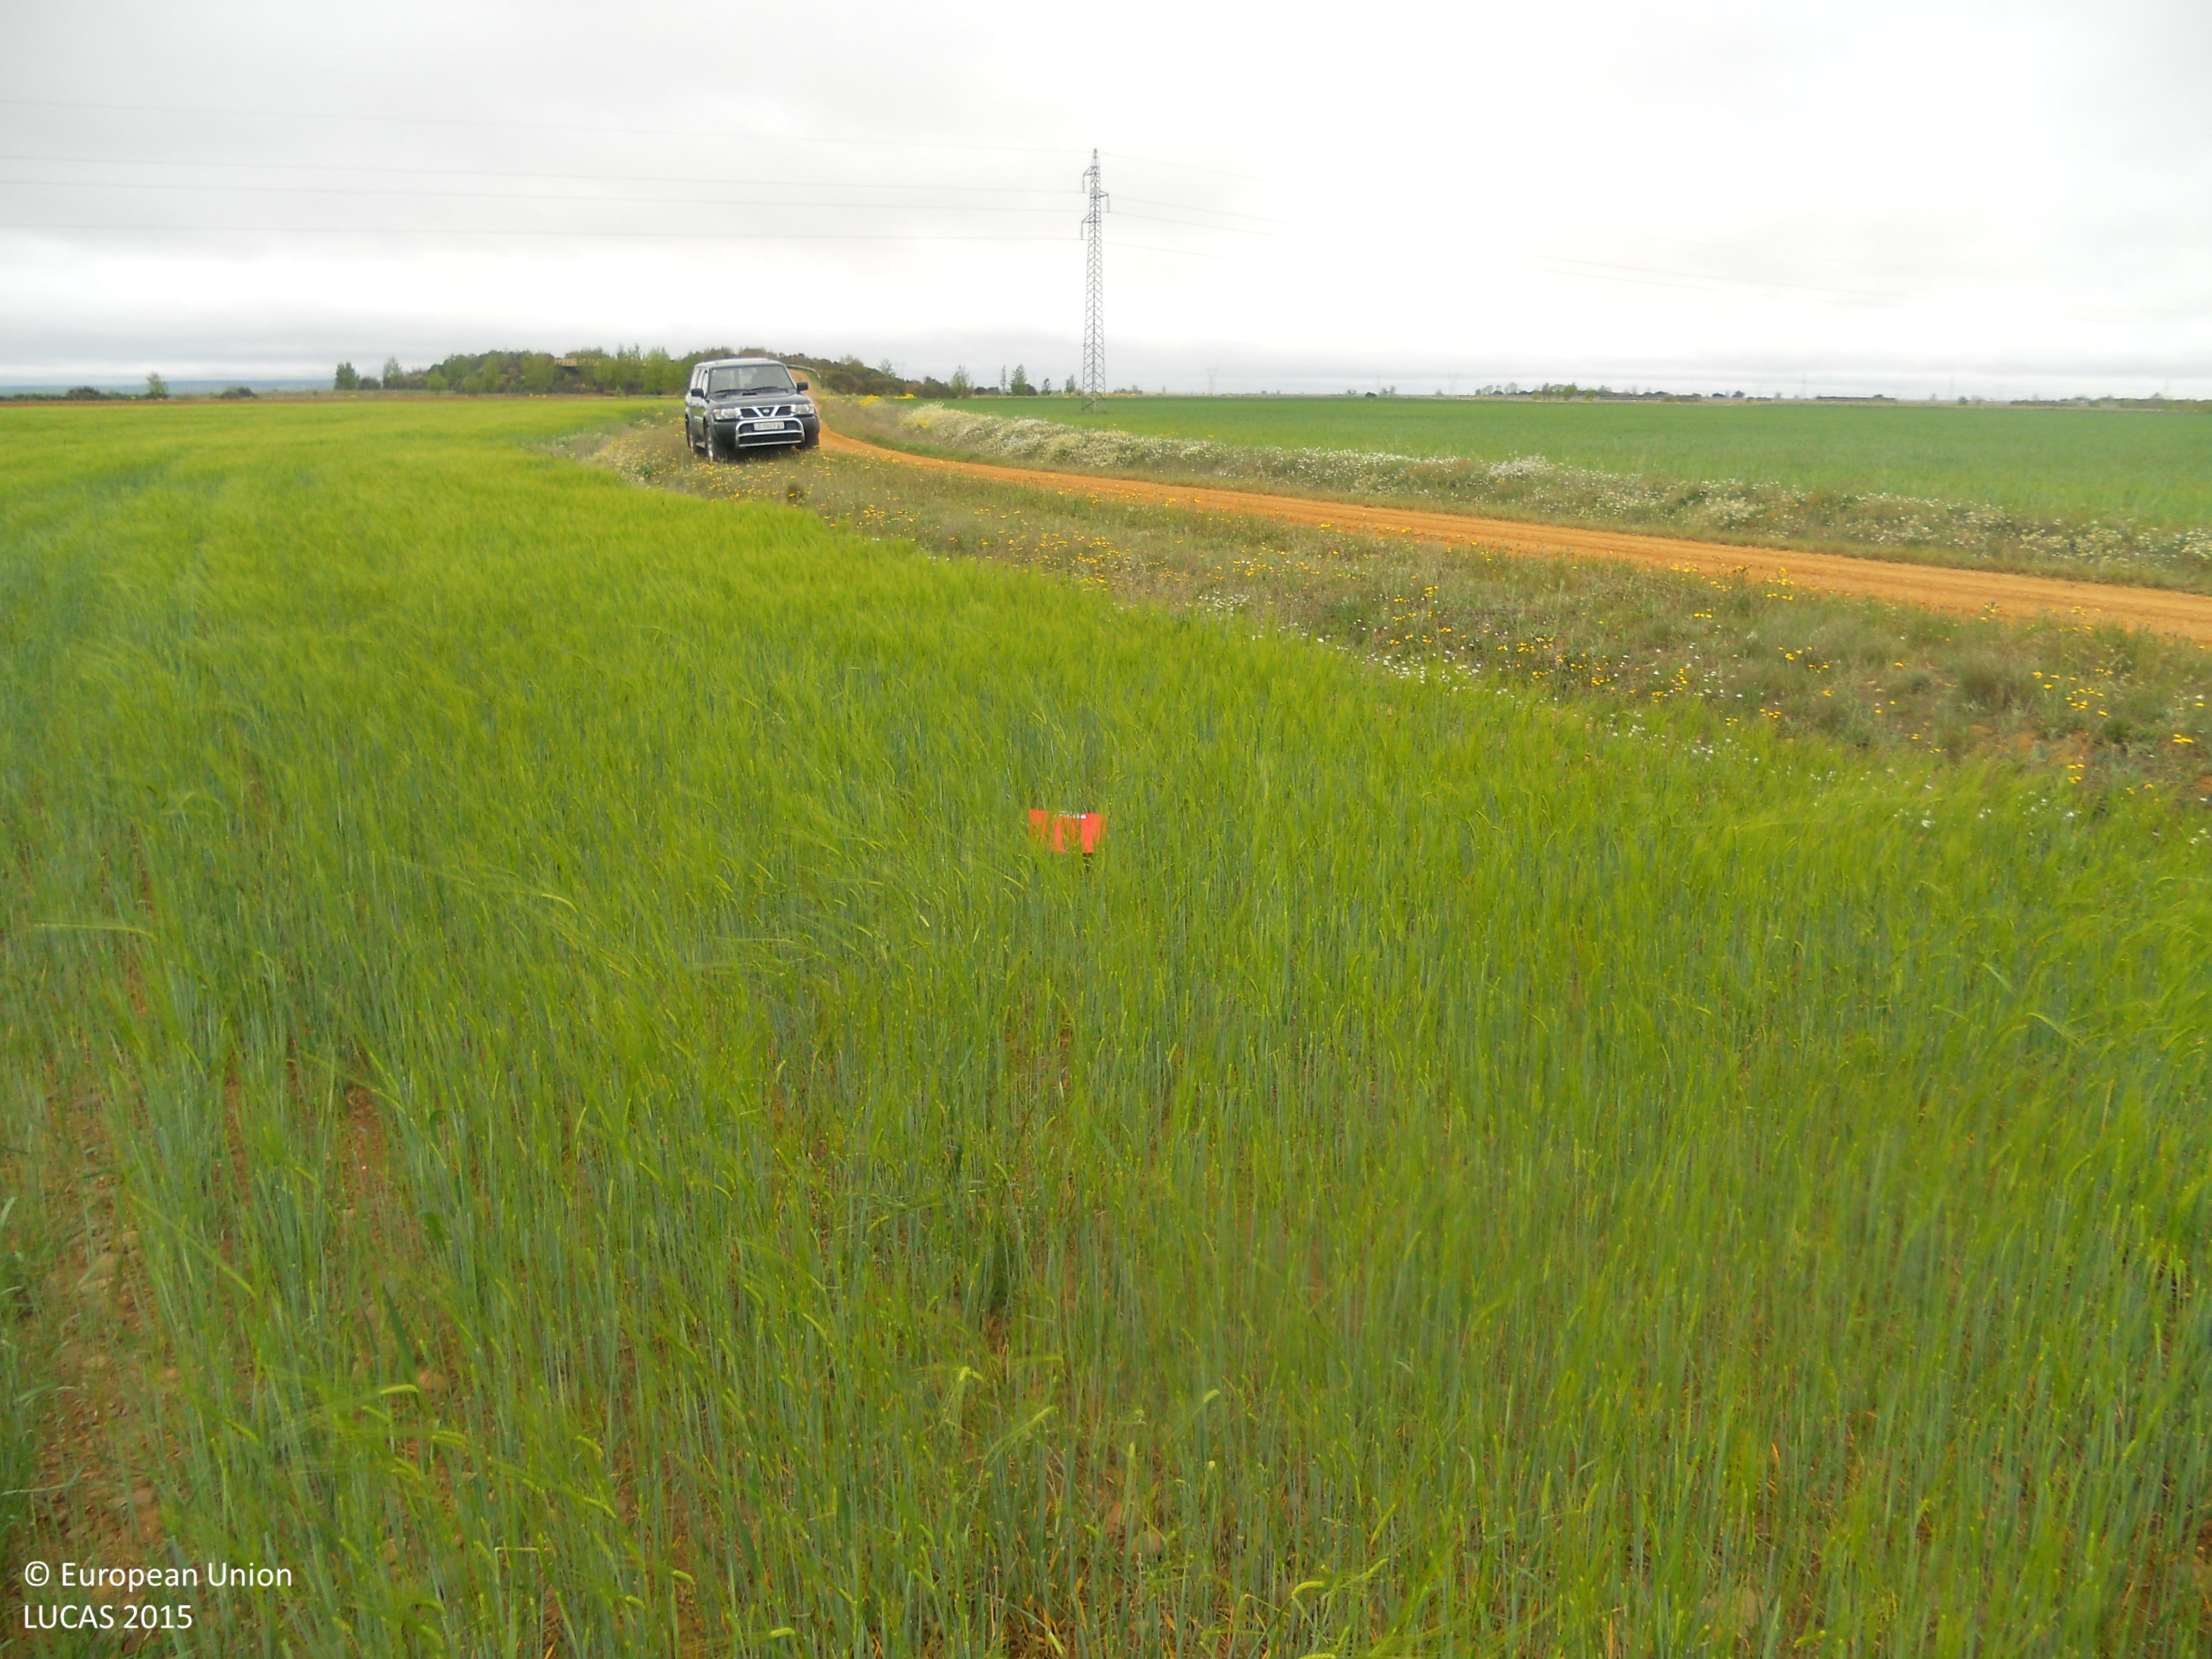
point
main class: Cropland
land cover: Barley
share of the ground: > 75 %
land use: Agriculture (excluding fallow land and kitchen gardens)
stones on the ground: < 10 %
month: May
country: ES
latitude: 42.4344
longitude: -5.3213
